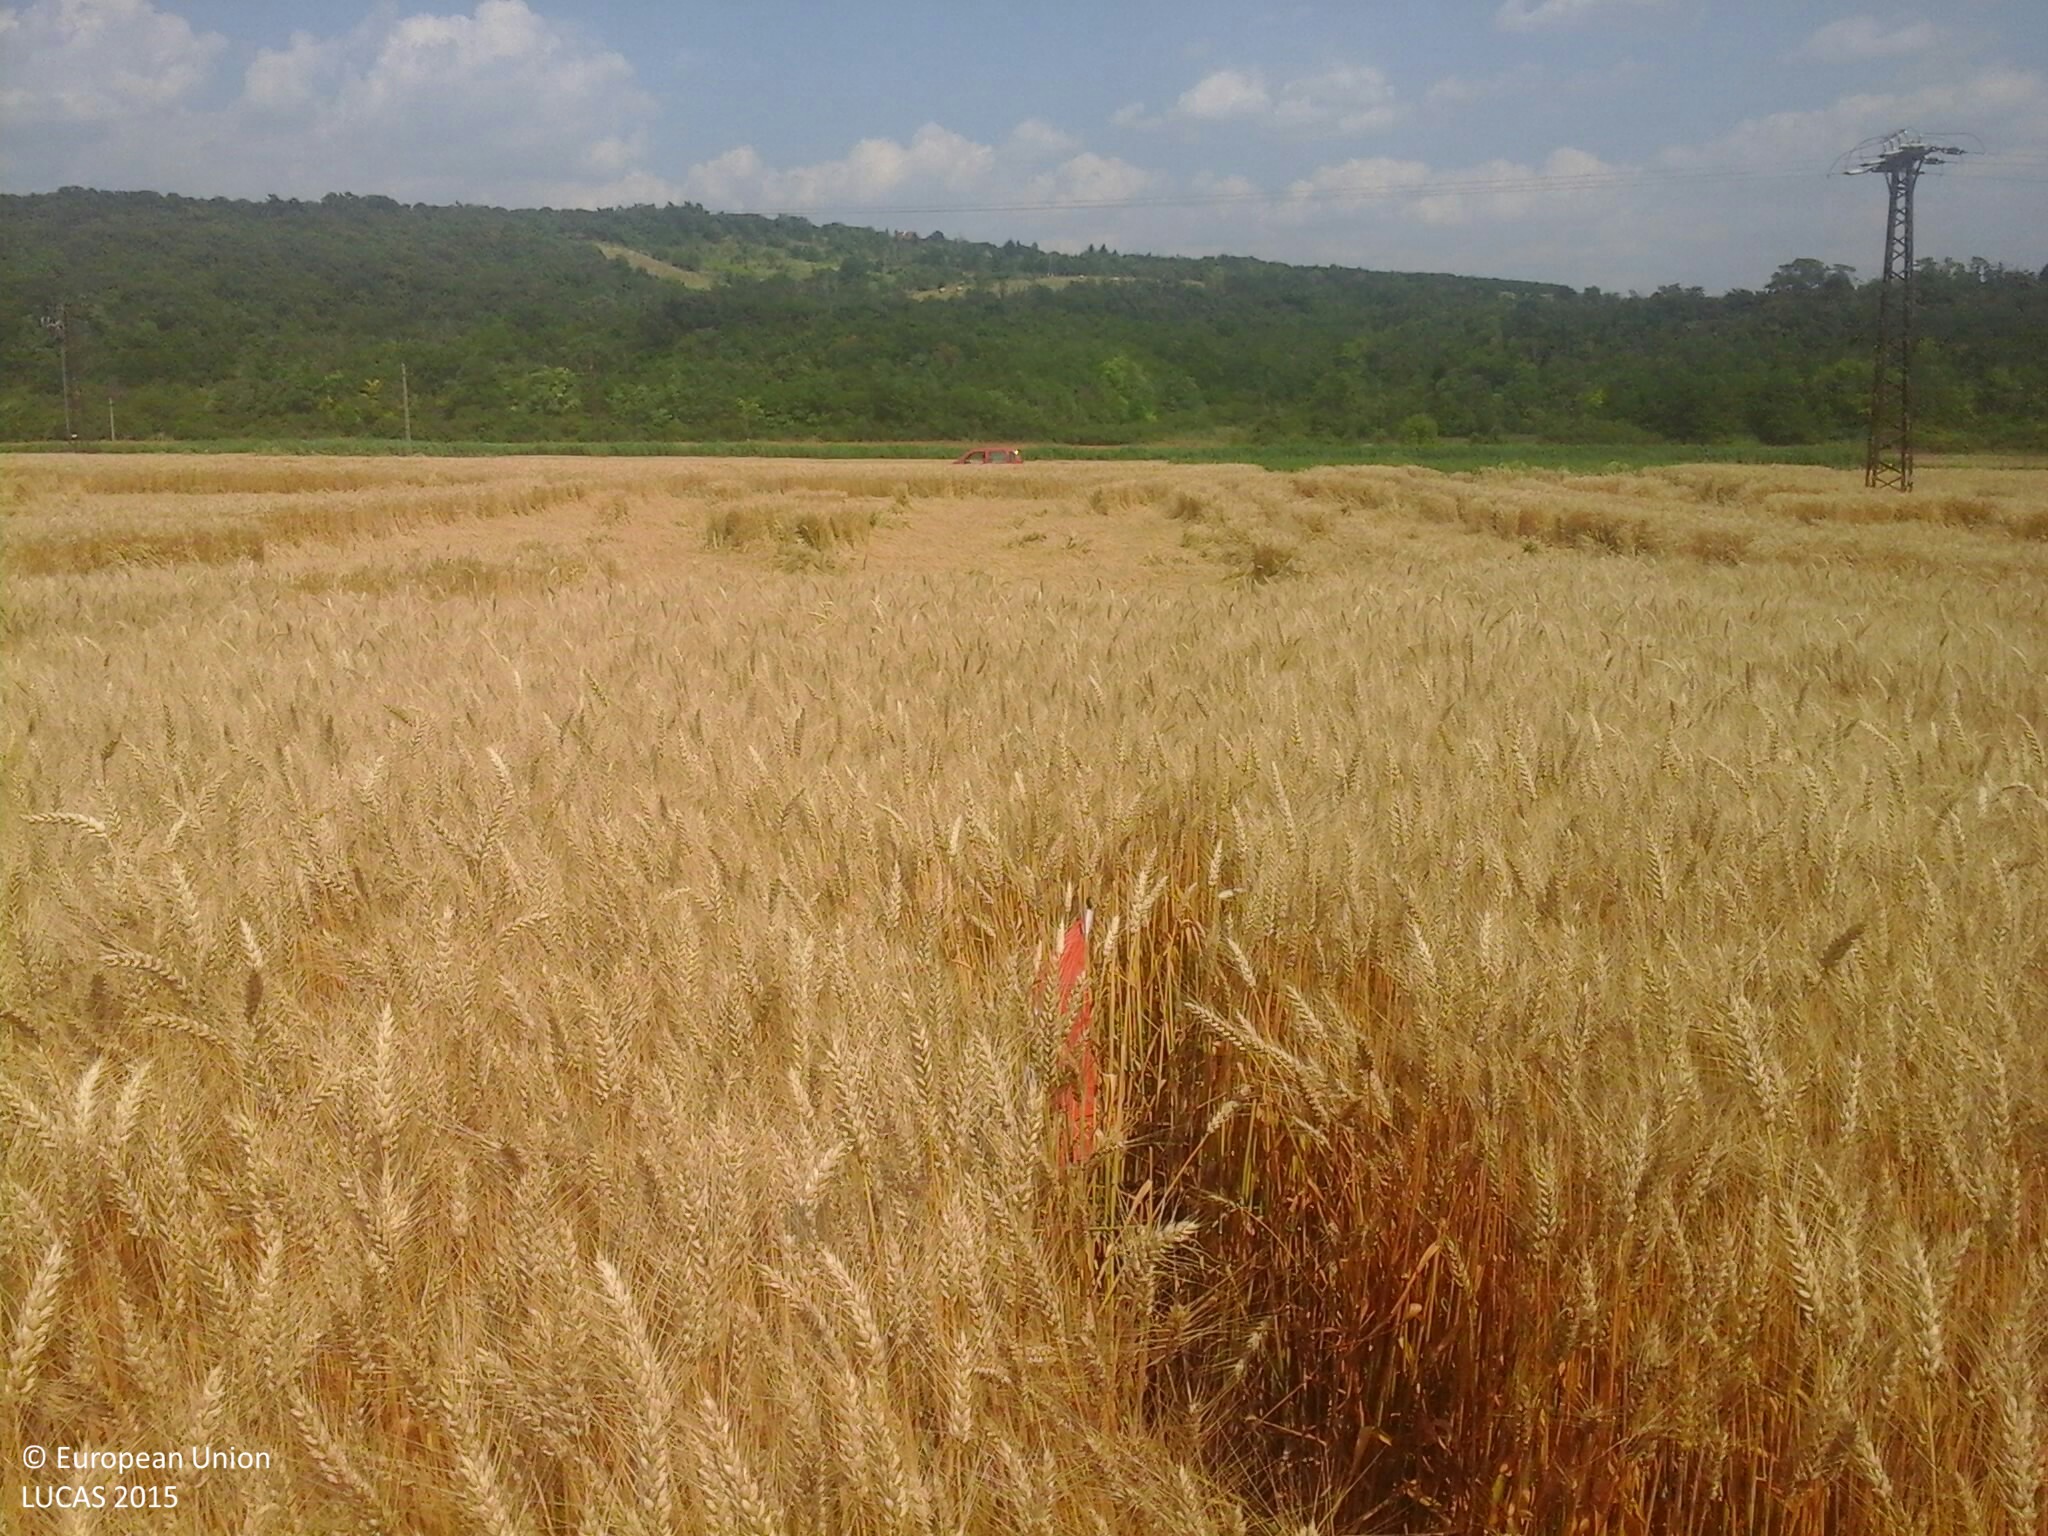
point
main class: Cropland
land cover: Common wheat
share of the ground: > 75 %
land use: Agriculture (excluding fallow land and kitchen gardens)
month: July
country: HU
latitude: 47.7825
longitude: 19.2160
